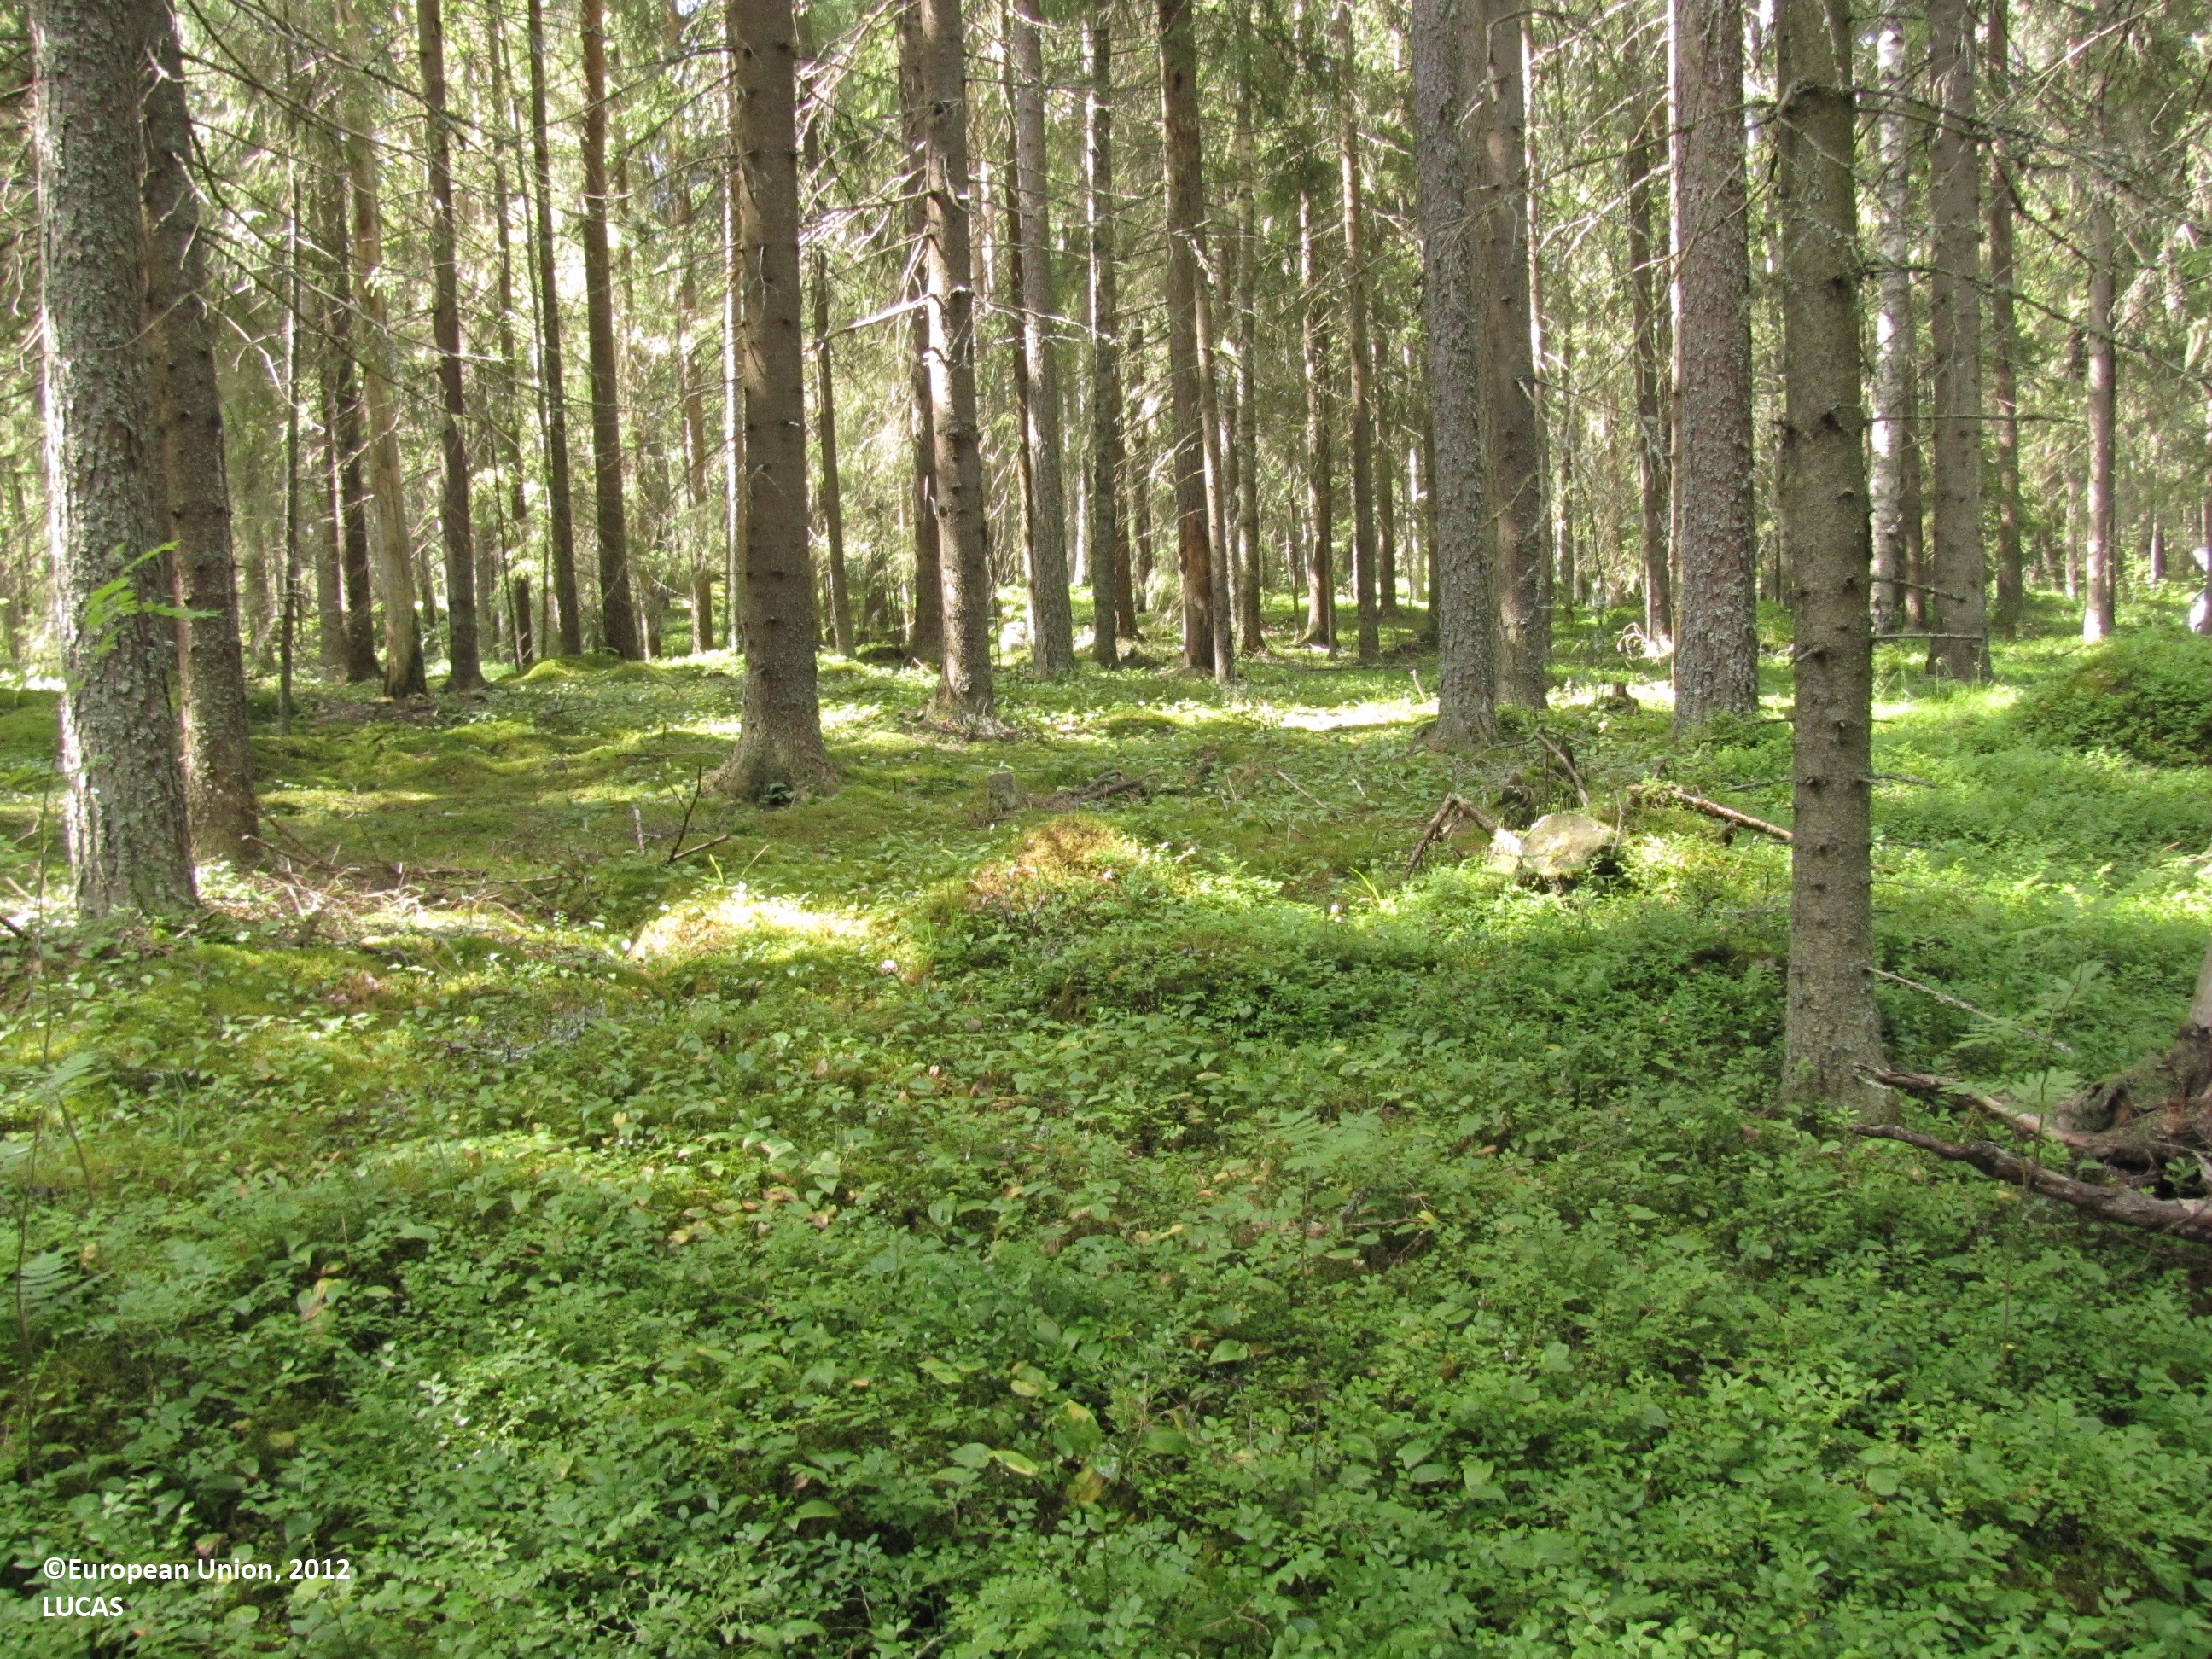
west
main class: Woodland
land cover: Spruce dominated coniferous woodland
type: boreal forest
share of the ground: > 75 %
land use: Forestry
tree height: > 5 m
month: July
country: FI
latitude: 62.4717
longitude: 23.1568
